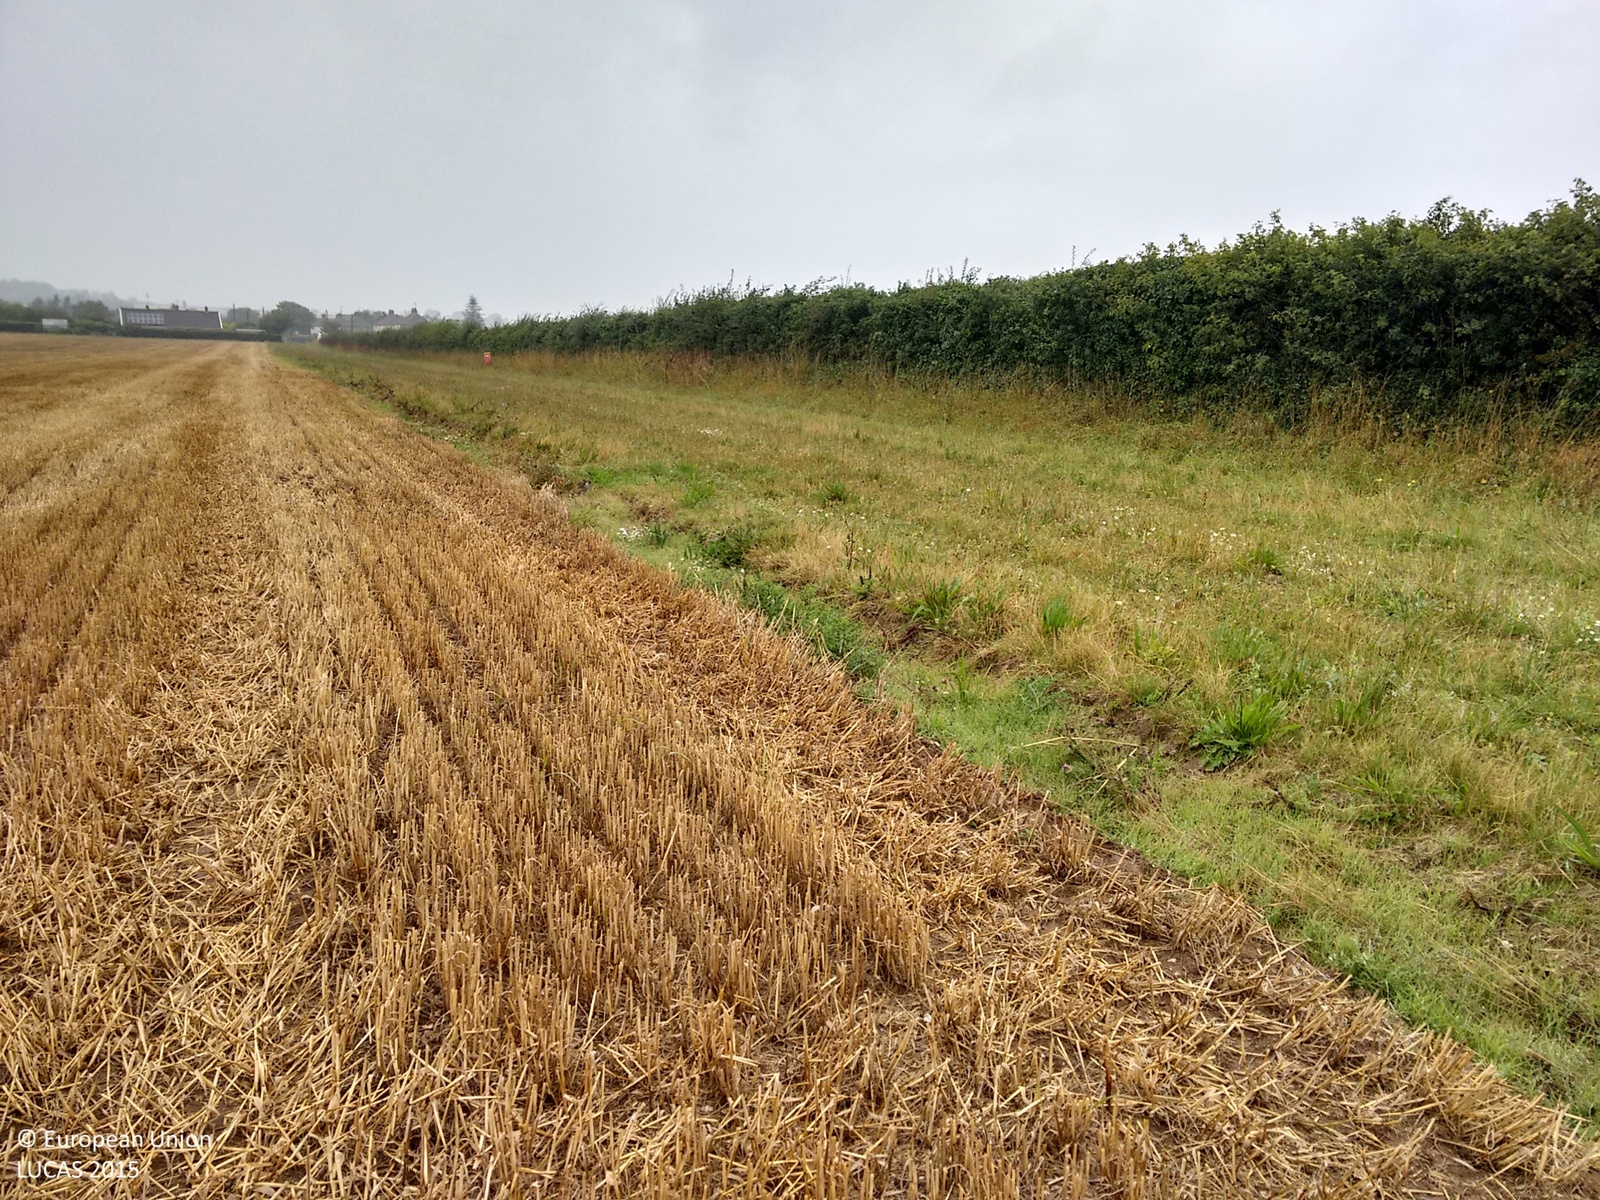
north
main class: Cropland
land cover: Common wheat
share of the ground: > 75 %
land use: Agriculture (excluding fallow land and kitchen gardens)
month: August
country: GB
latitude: 52.9375
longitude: 0.7350
